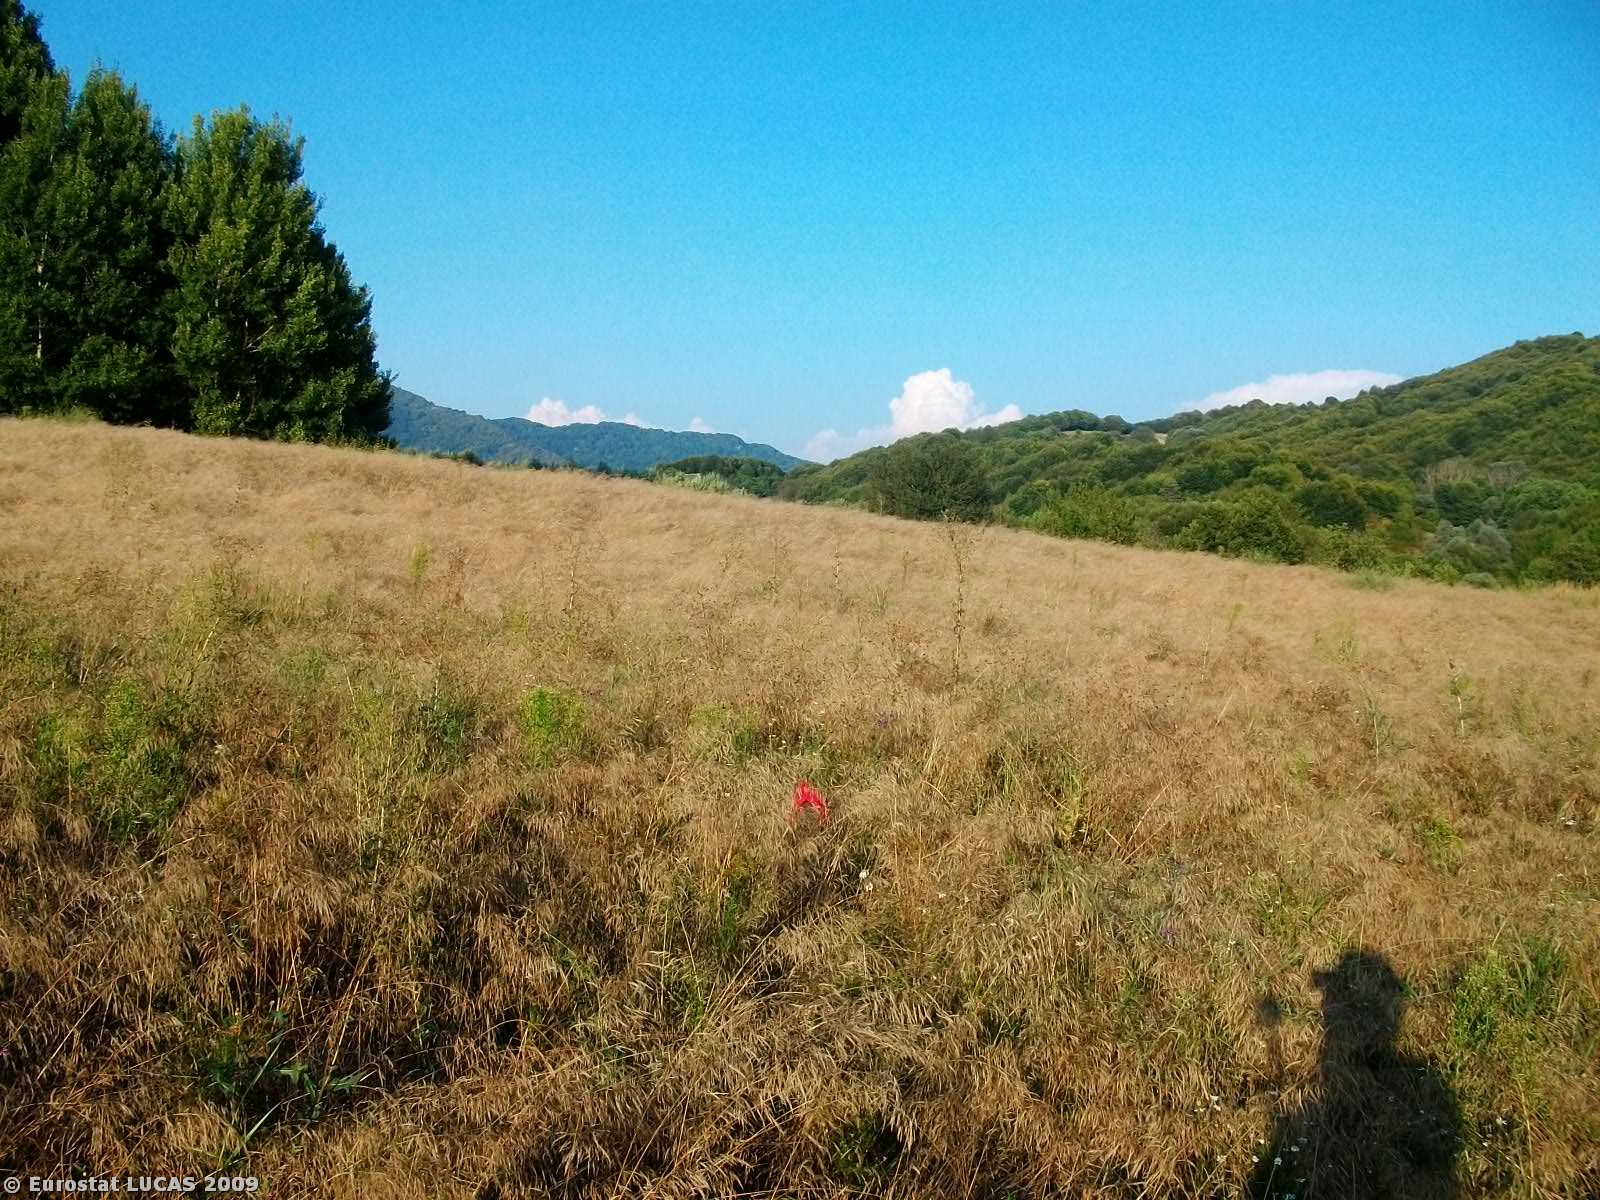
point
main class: Grassland
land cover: Grassland without tree/shrub cover
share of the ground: > 75 %
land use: Unused
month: September
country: GR
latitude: 41.2798
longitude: 23.6946
